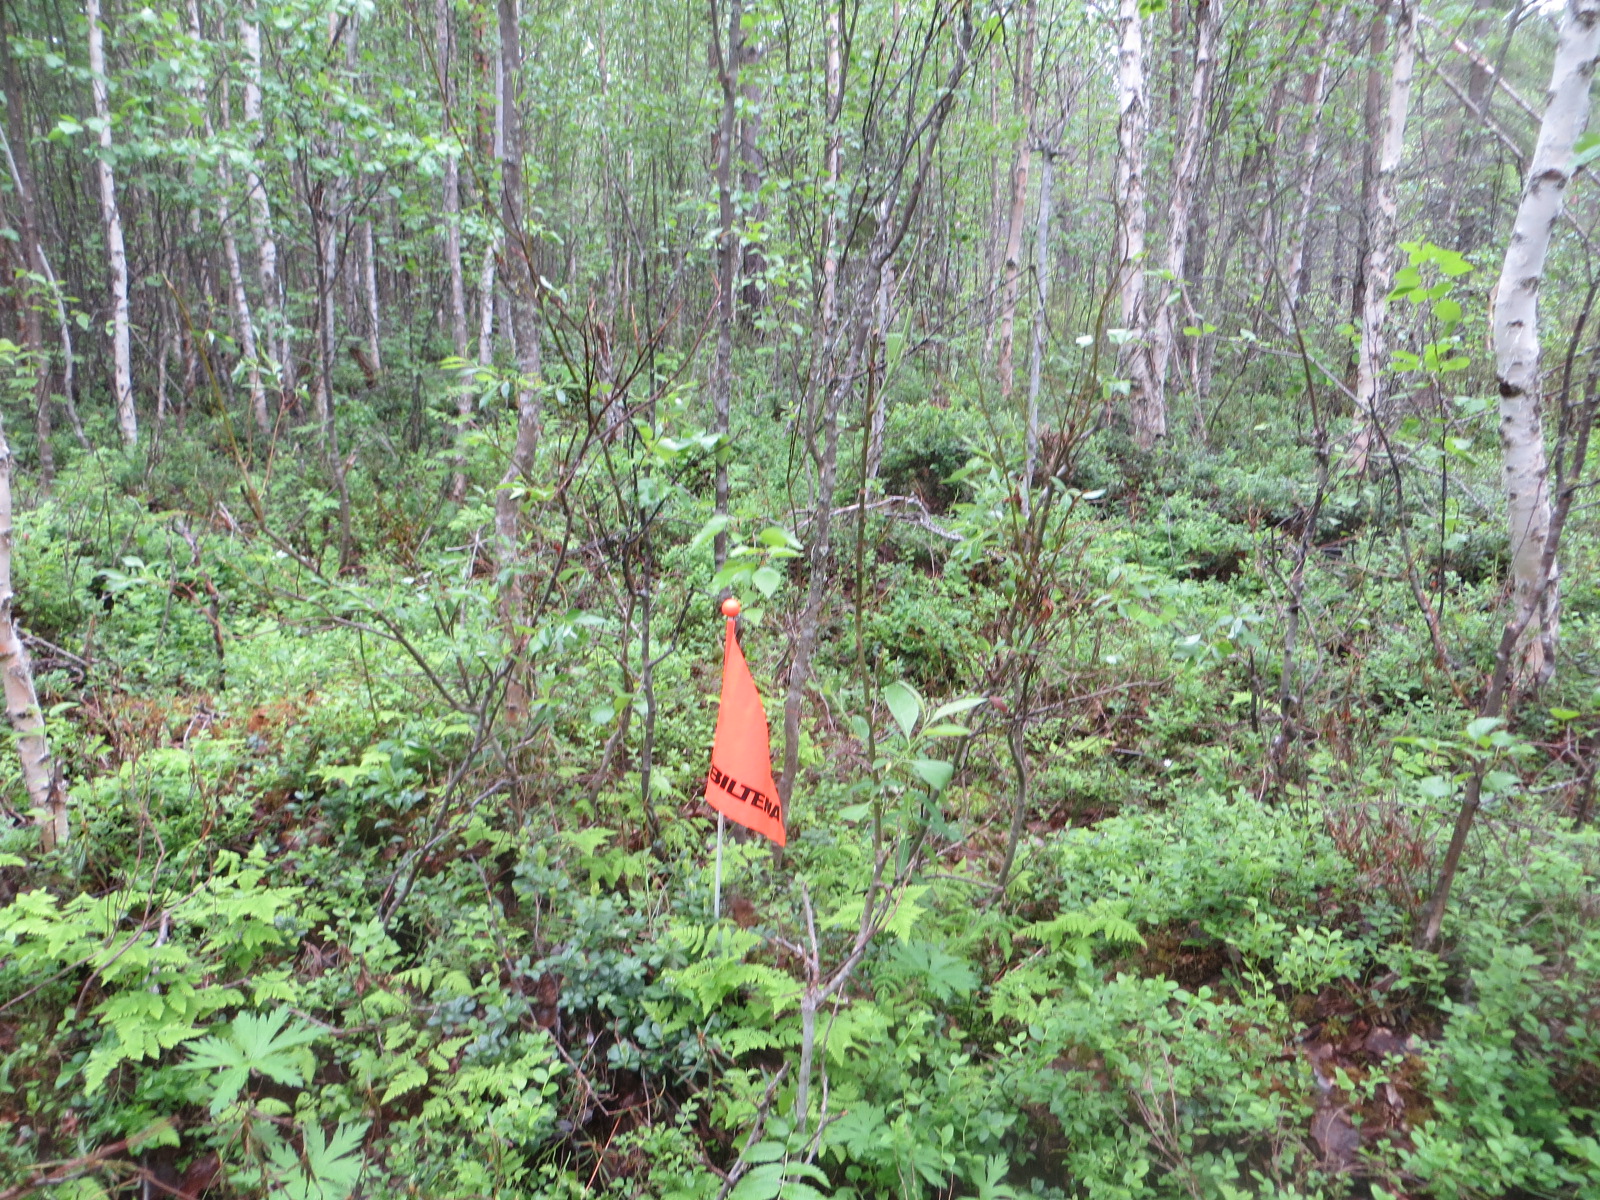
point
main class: Woodland
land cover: Pine dominated mixed woodland
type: boreal forest
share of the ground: > 75 %
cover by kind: broadleaved forest trees 45 %, coniferous forest trees 35 %, shrubs 20 %
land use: Forestry
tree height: > 5 m
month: June
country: FI
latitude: 66.4297
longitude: 26.4237
